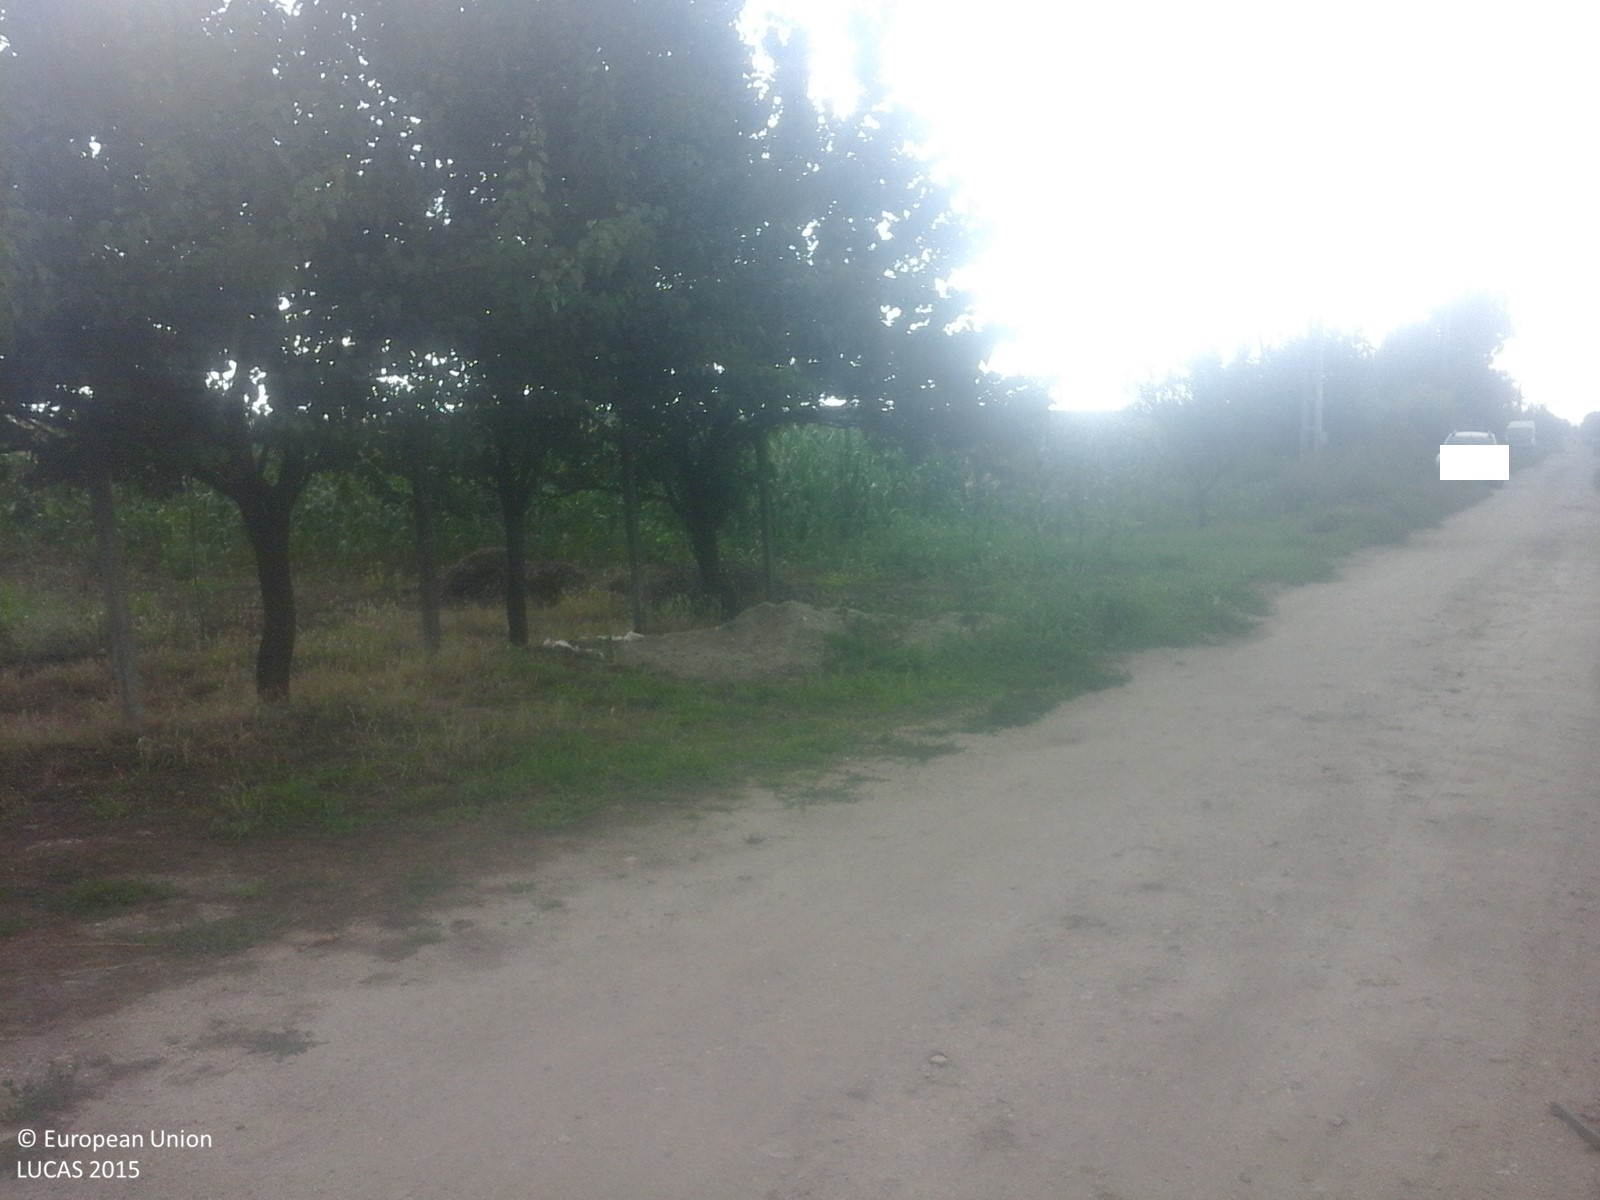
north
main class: Cropland
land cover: Maize
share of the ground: > 75 %
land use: Agriculture (excluding fallow land and kitchen gardens)
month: July
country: RO
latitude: 43.8555
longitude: 24.6357
